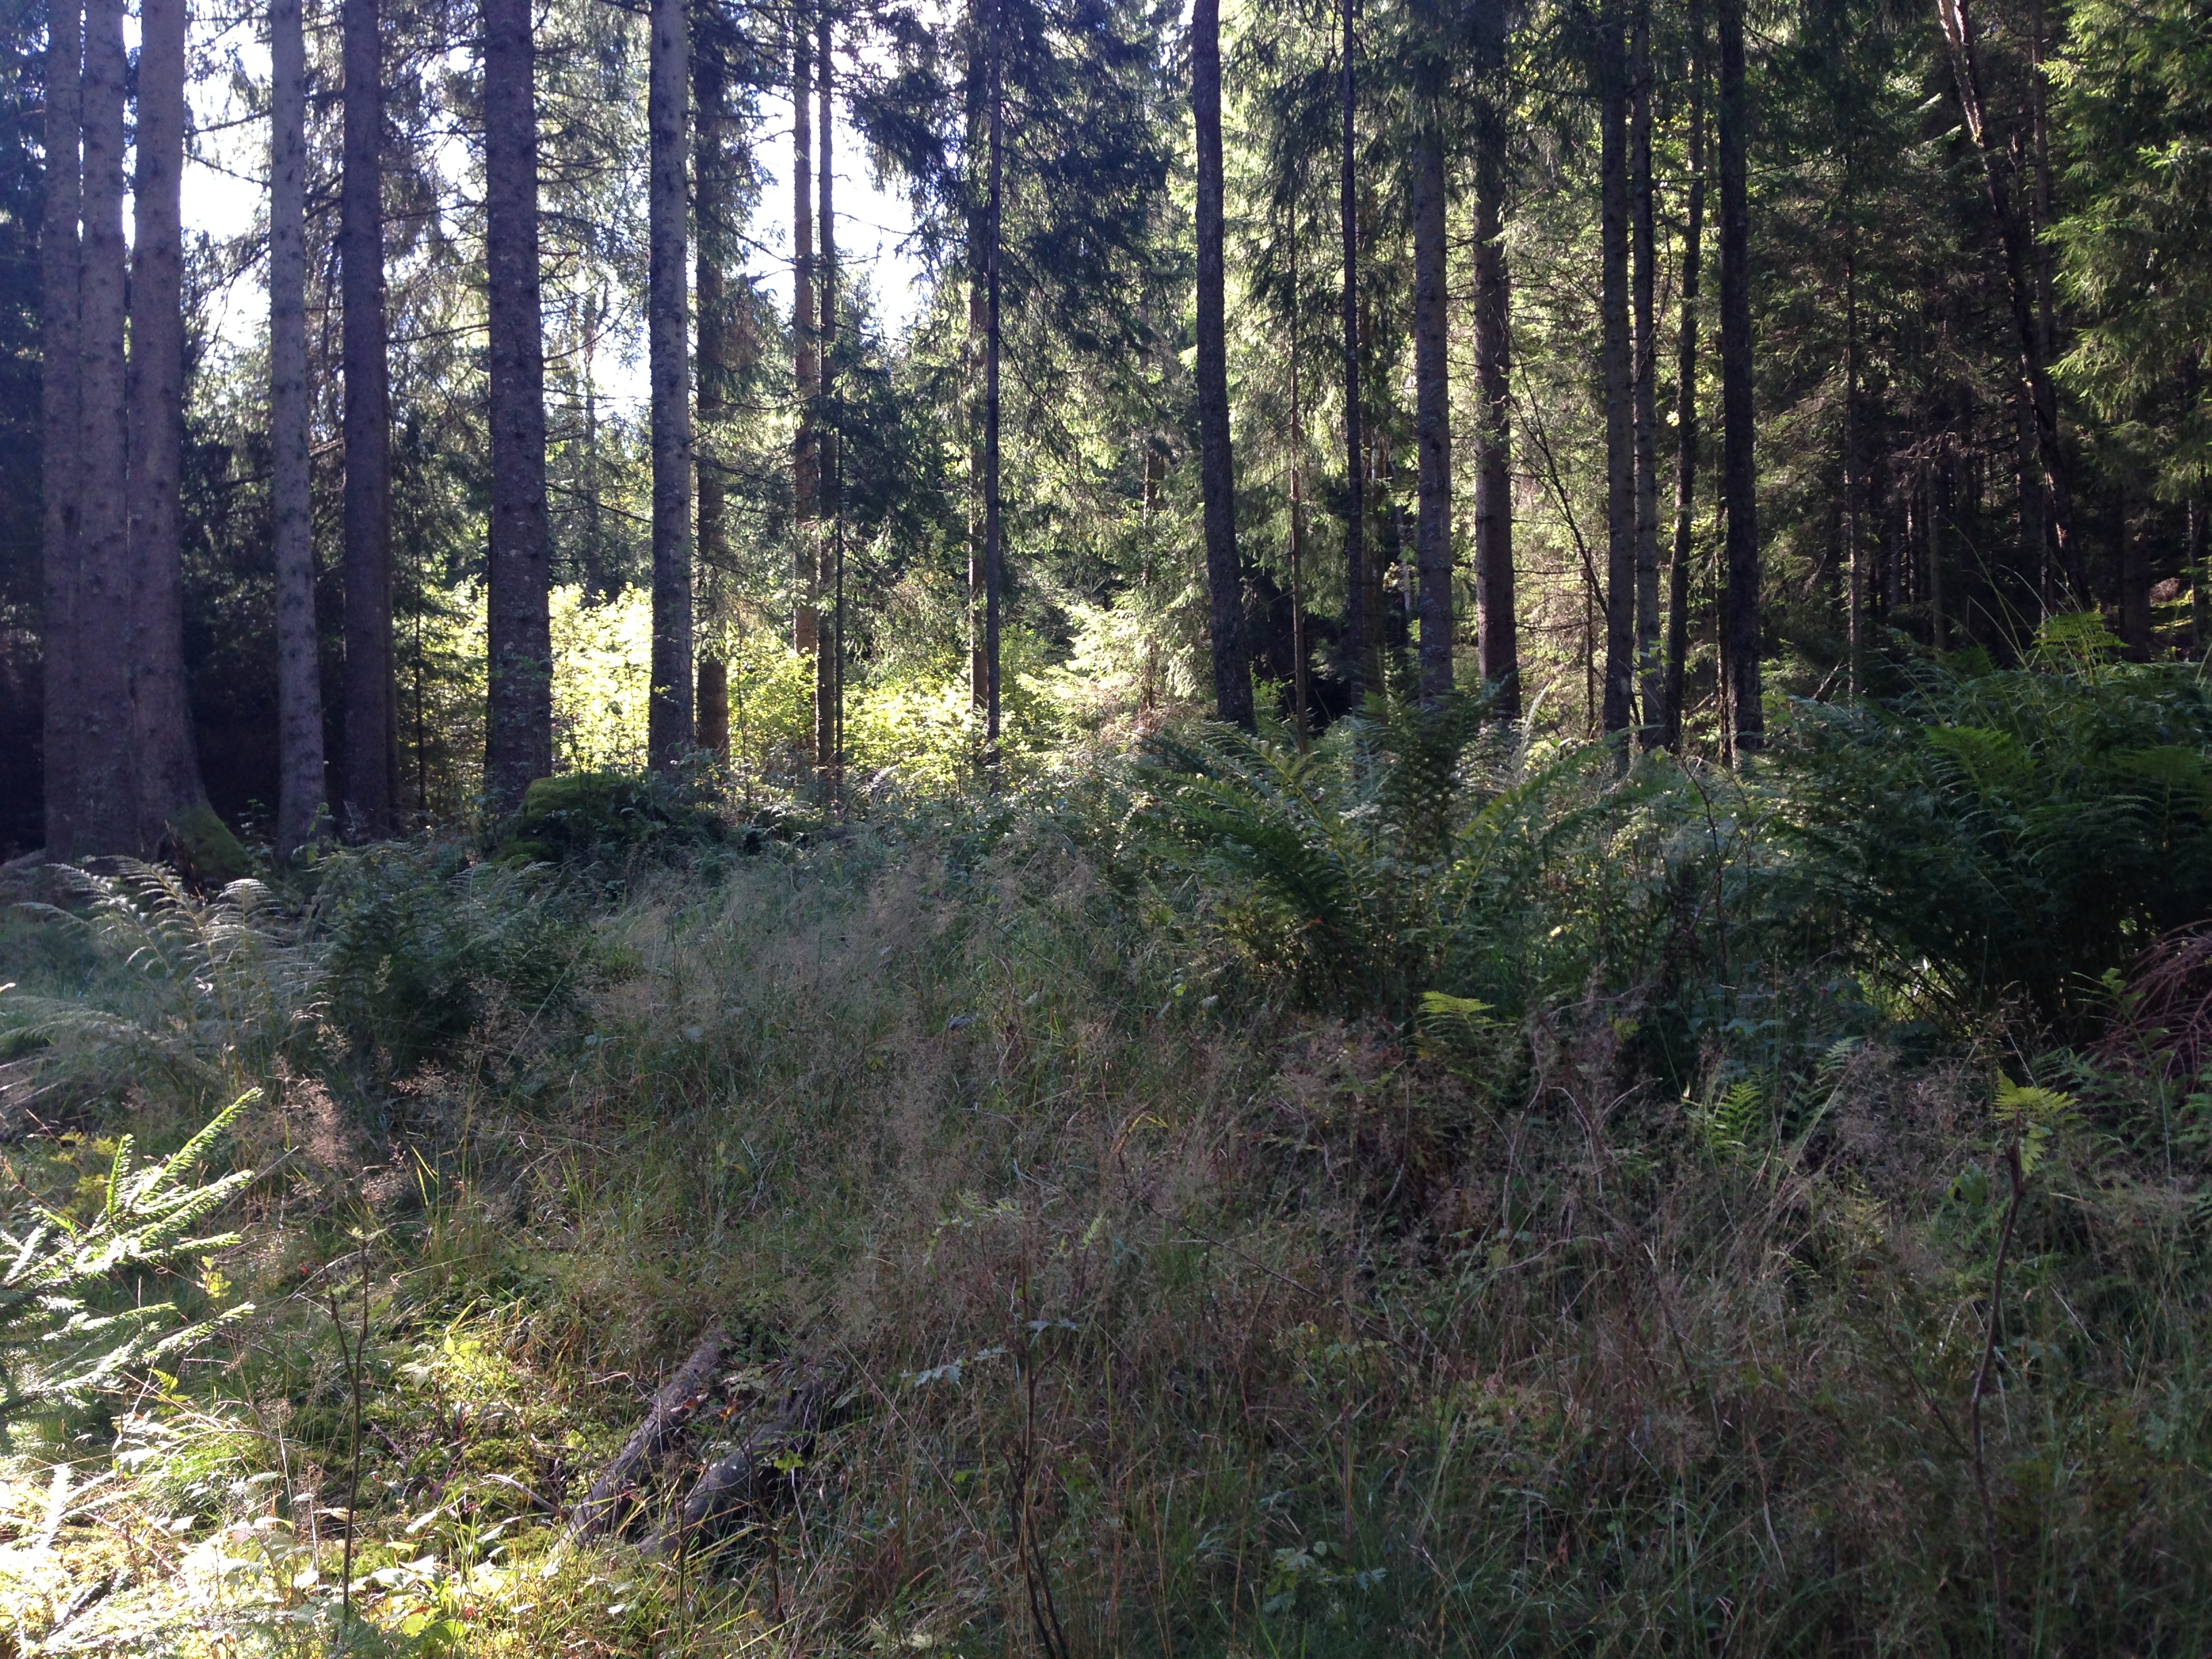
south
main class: Woodland
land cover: Spruce dominated coniferous woodland
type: boreal forest
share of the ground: 50 - 75 %
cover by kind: coniferous forest trees 70 %, shrubs 15 %, herbaceous plants 15 %
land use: Forestry
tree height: > 5 m
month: September
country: SE
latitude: 57.2081
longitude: 13.2575
